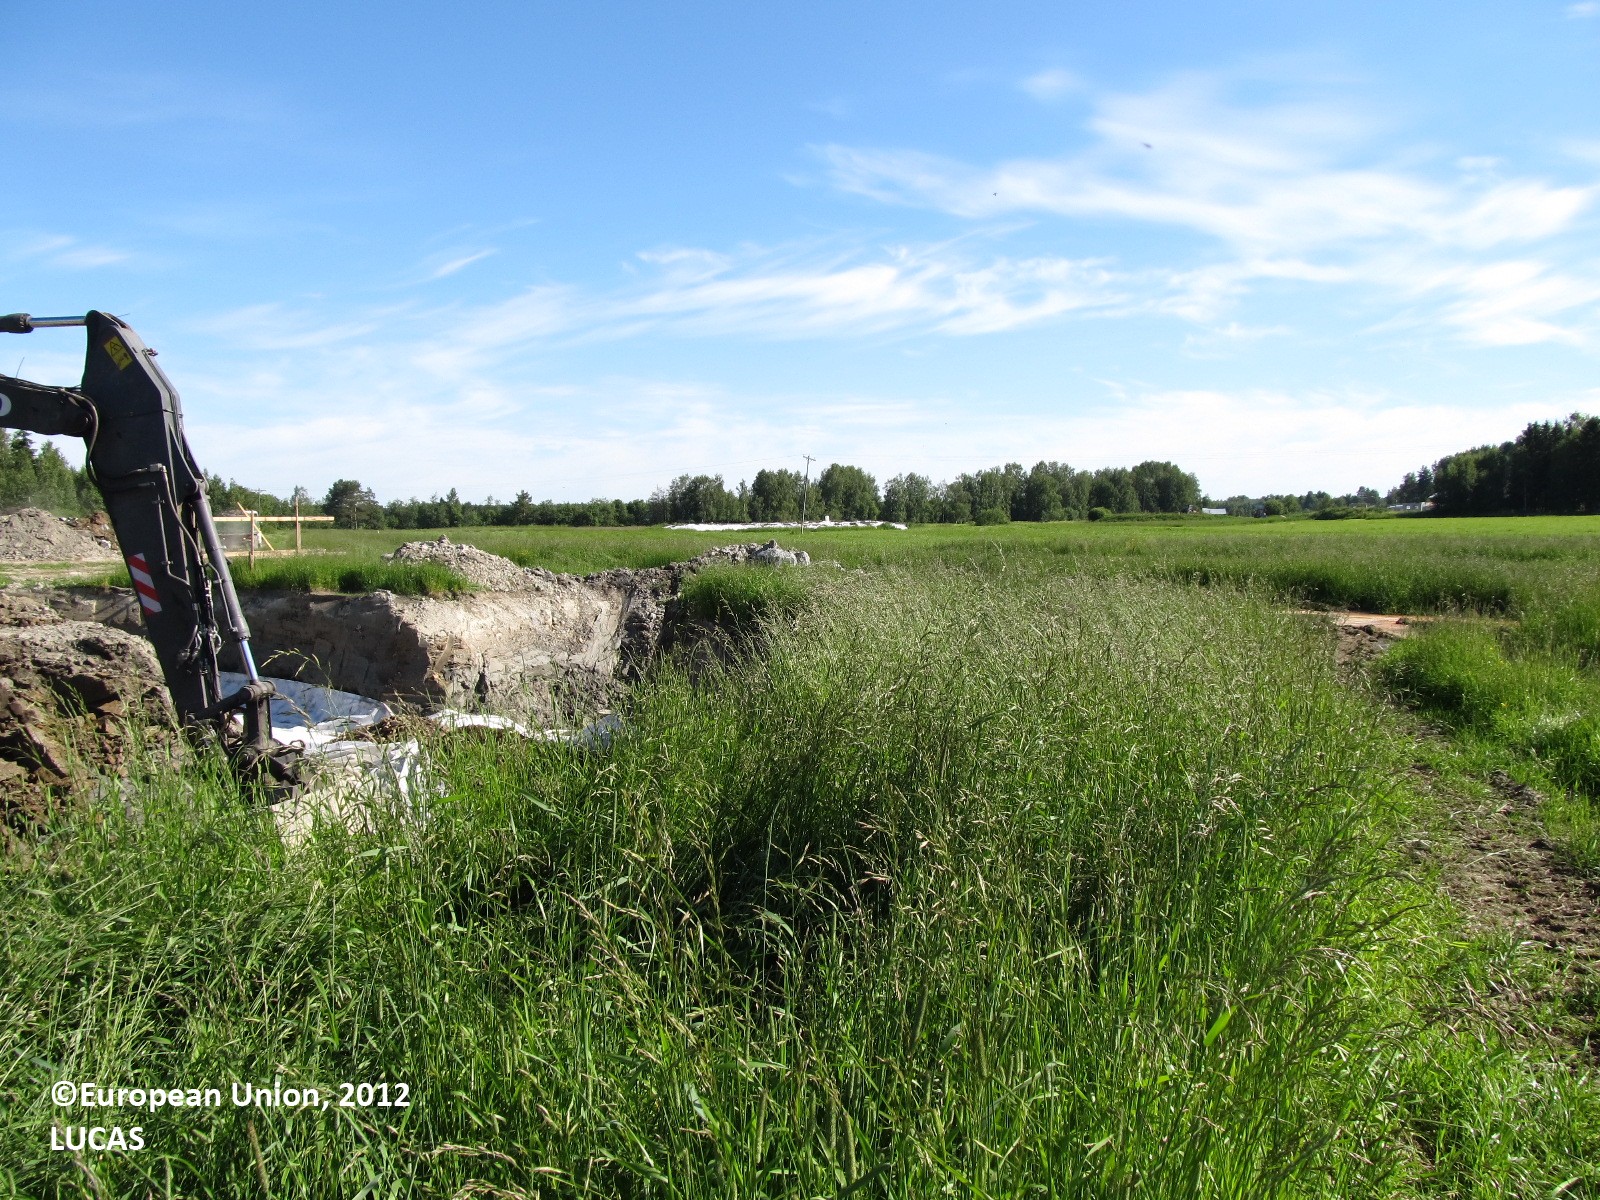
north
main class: Grassland
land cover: Grassland without tree/shrub cover
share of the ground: > 75 %
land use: Agriculture (excluding fallow land and kitchen gardens)
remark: Harvested field
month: July
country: FI
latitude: 62.6320
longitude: 29.1576
